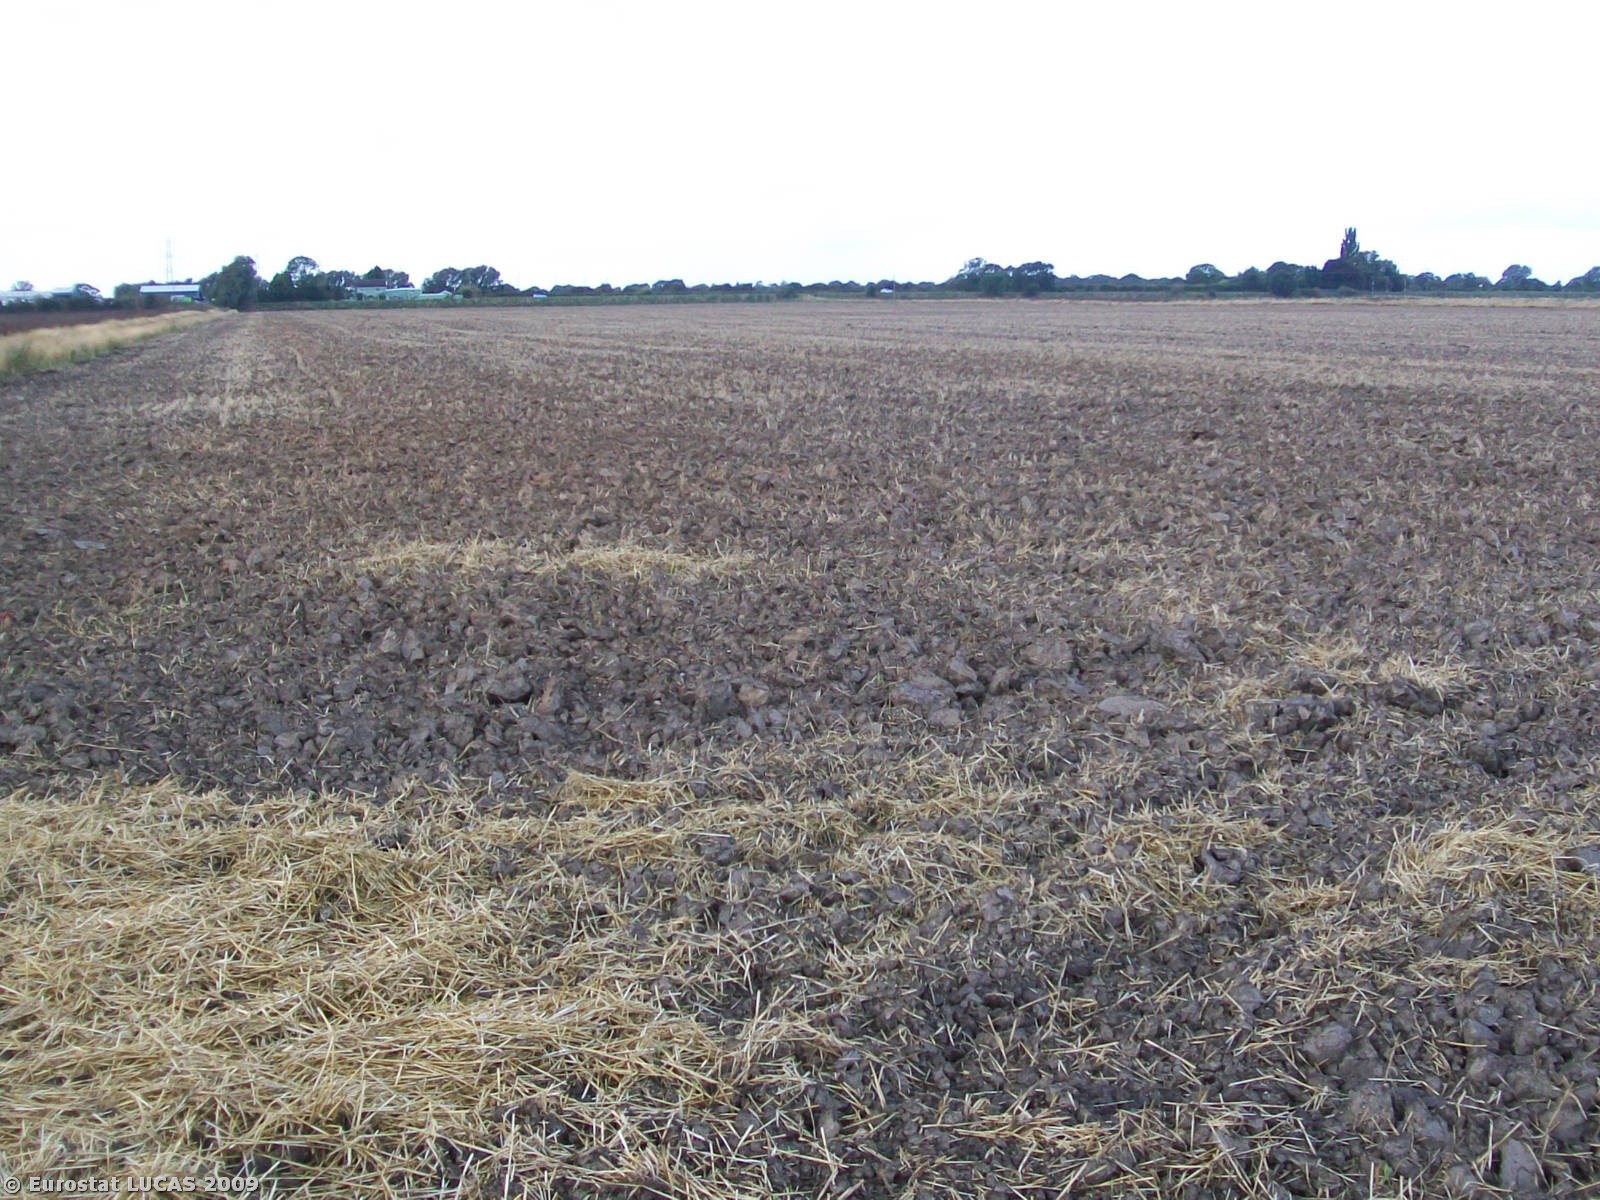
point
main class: Cropland
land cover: Barley
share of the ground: < 10 %
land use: Agriculture (excluding fallow land and kitchen gardens)
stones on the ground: < 10 %
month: August
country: GB
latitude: 53.6275
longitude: -0.9753
